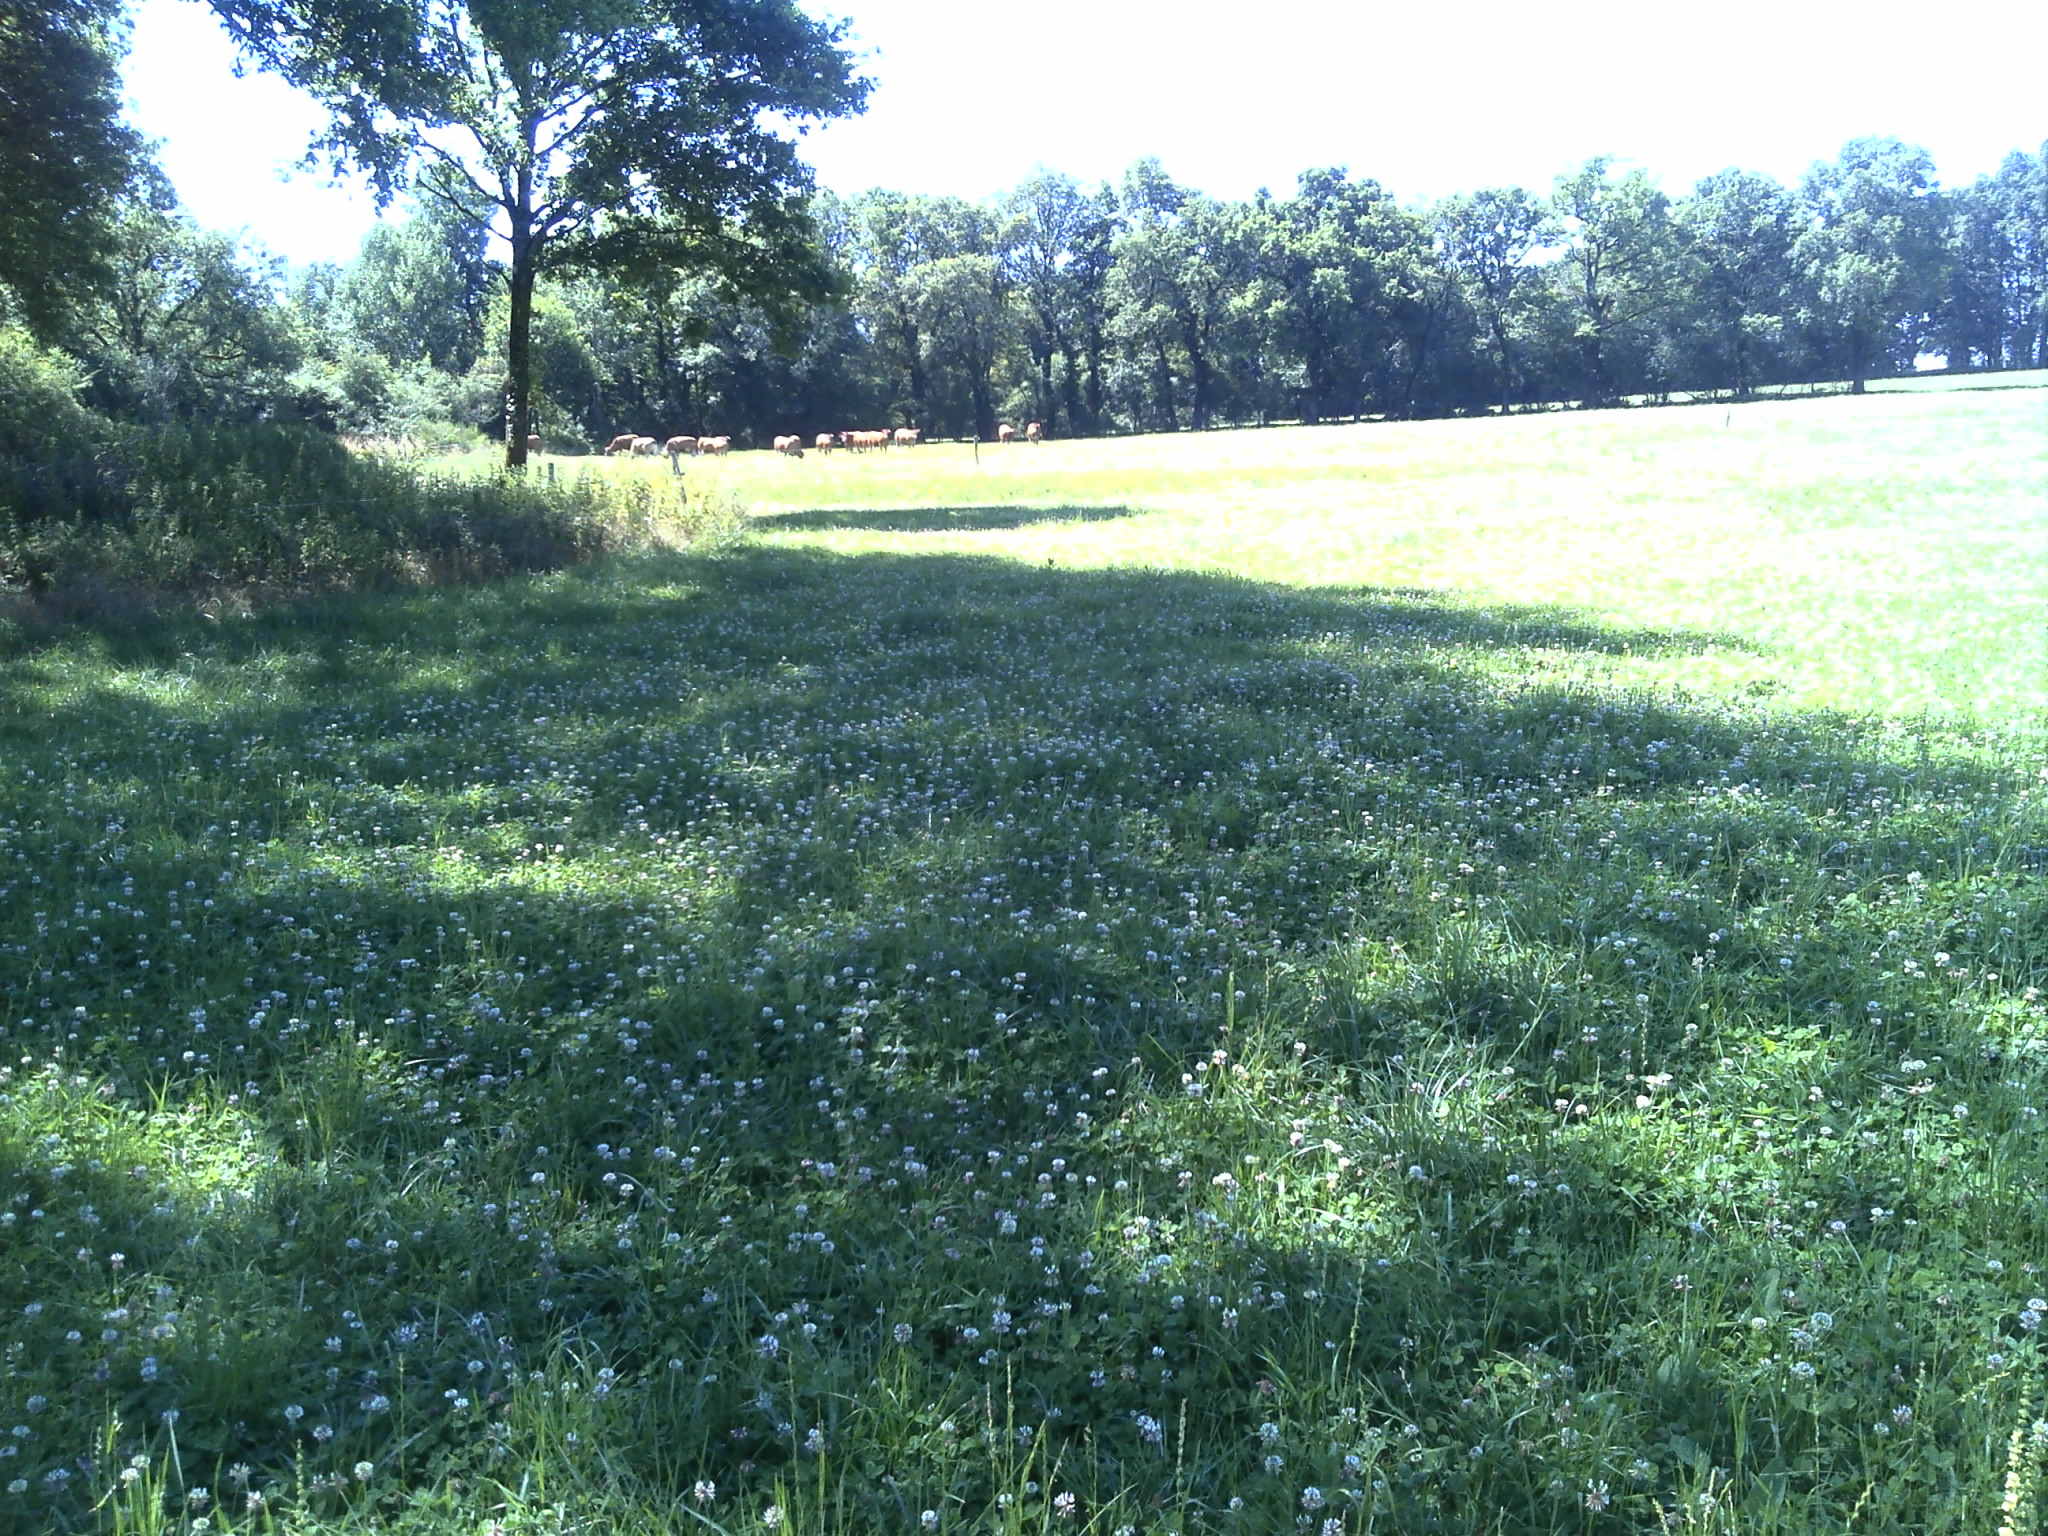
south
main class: Cropland
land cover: Clovers
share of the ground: > 75 %
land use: Agriculture (excluding fallow land and kitchen gardens)
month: June
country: FR
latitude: 46.6532
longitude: 1.1404
